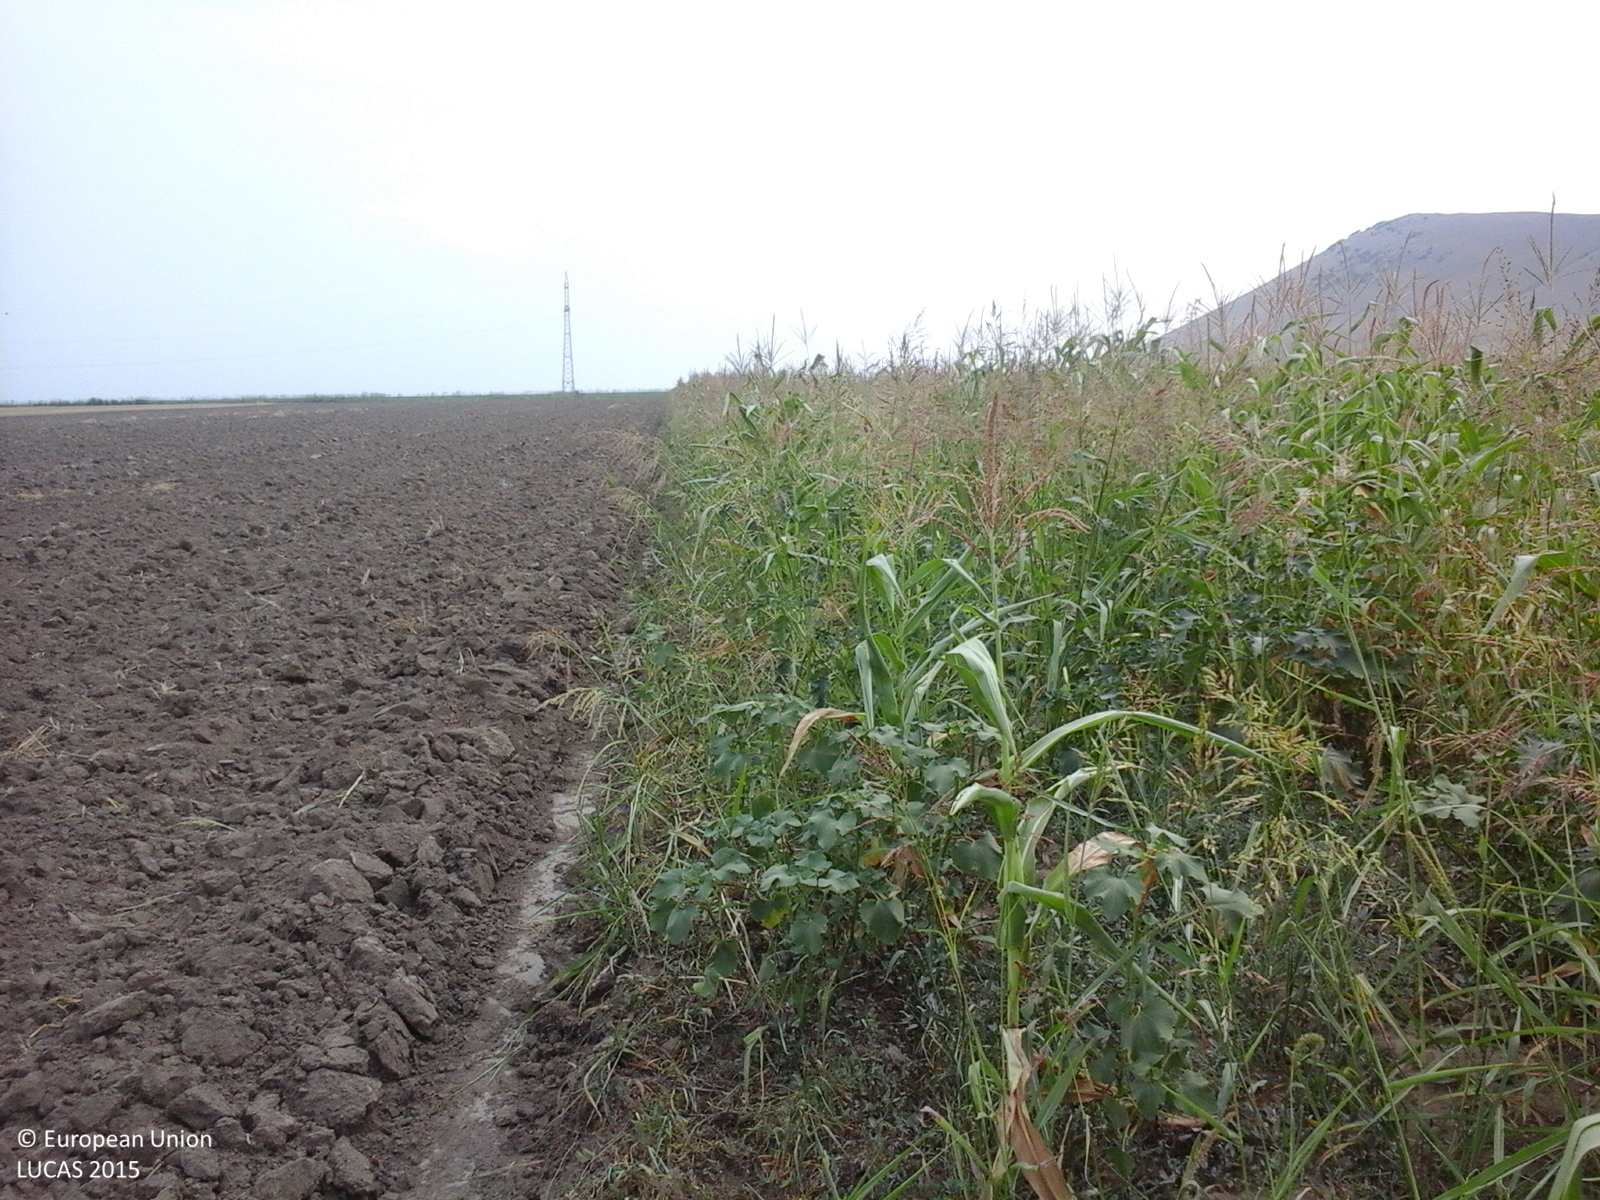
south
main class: Cropland
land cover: Maize
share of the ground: > 75 %
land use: Agriculture (excluding fallow land and kitchen gardens)
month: July
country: RO
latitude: 45.0152
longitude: 28.7001
